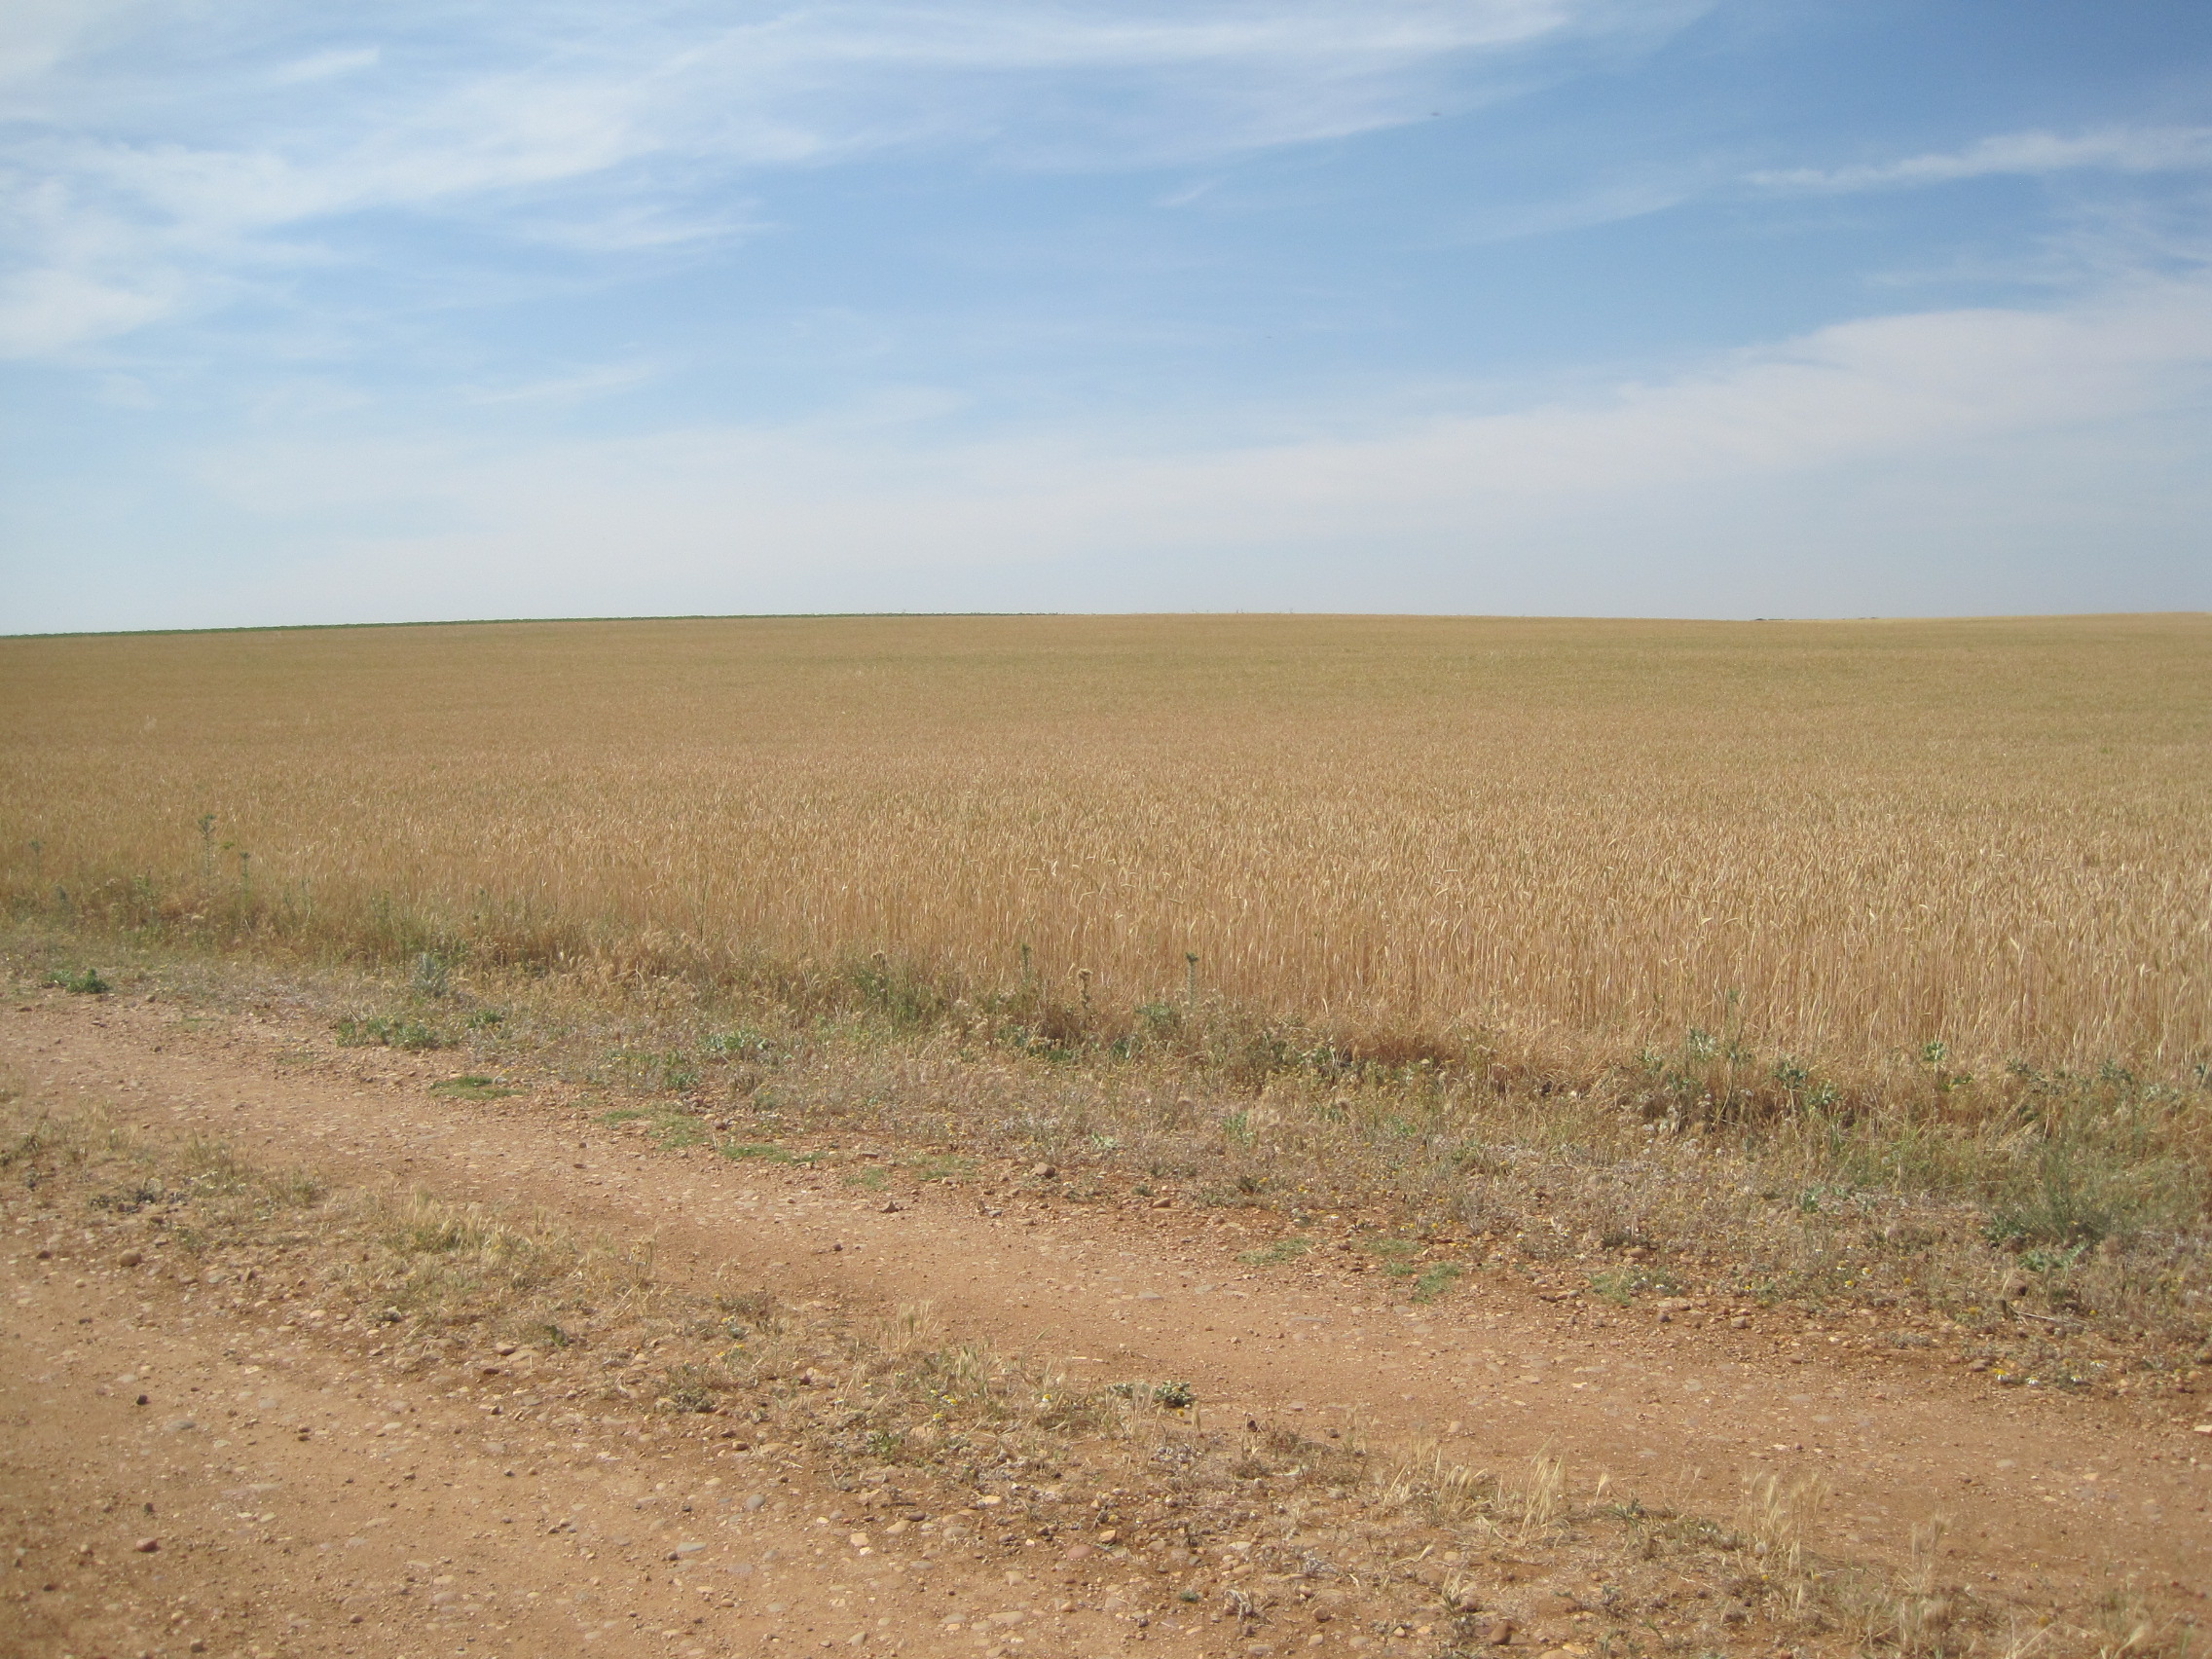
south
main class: Cropland
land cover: Sunflower
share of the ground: 50 - 75 %
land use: Agriculture (excluding fallow land and kitchen gardens)
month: June
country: ES
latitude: 41.3641
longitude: -5.1232
